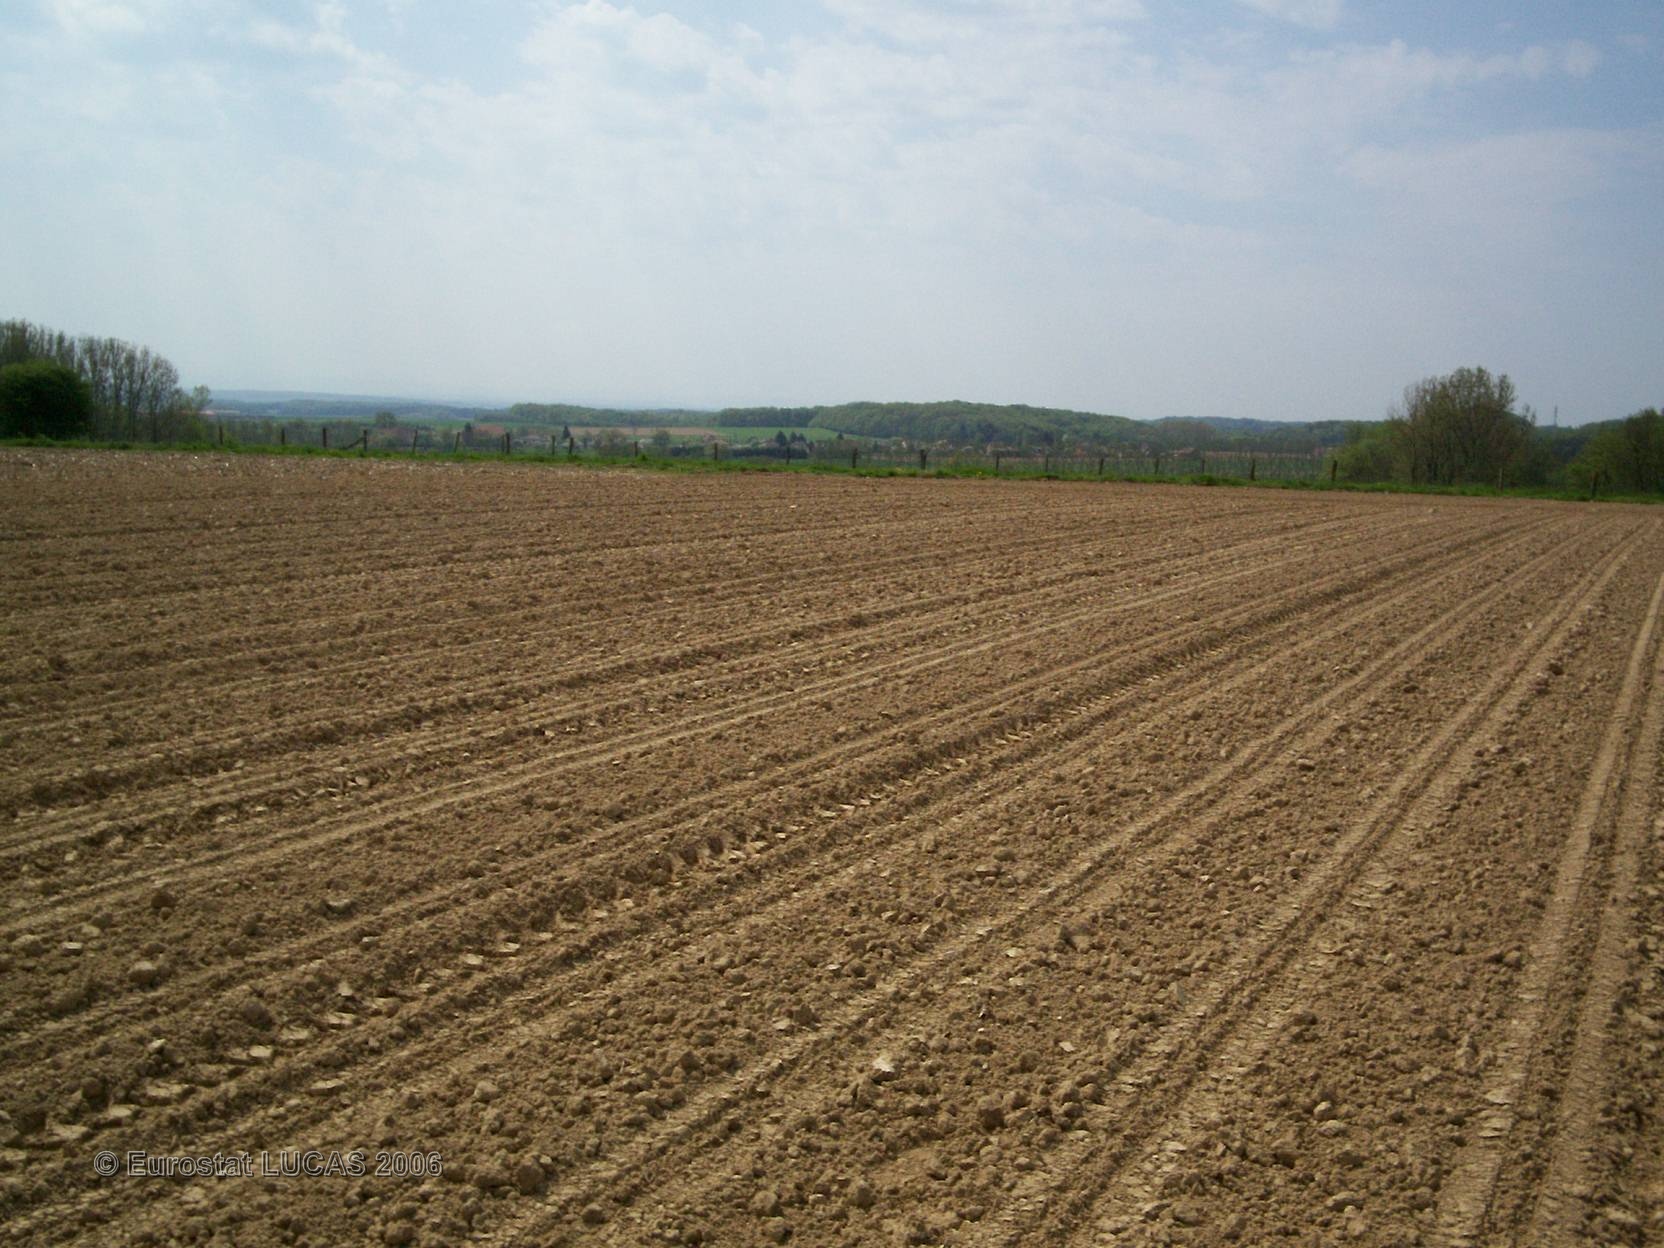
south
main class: Cropland
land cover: Maize
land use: Agriculture (excluding fallow land and kitchen gardens)
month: May
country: FR
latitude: 47.7174
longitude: 7.1088
